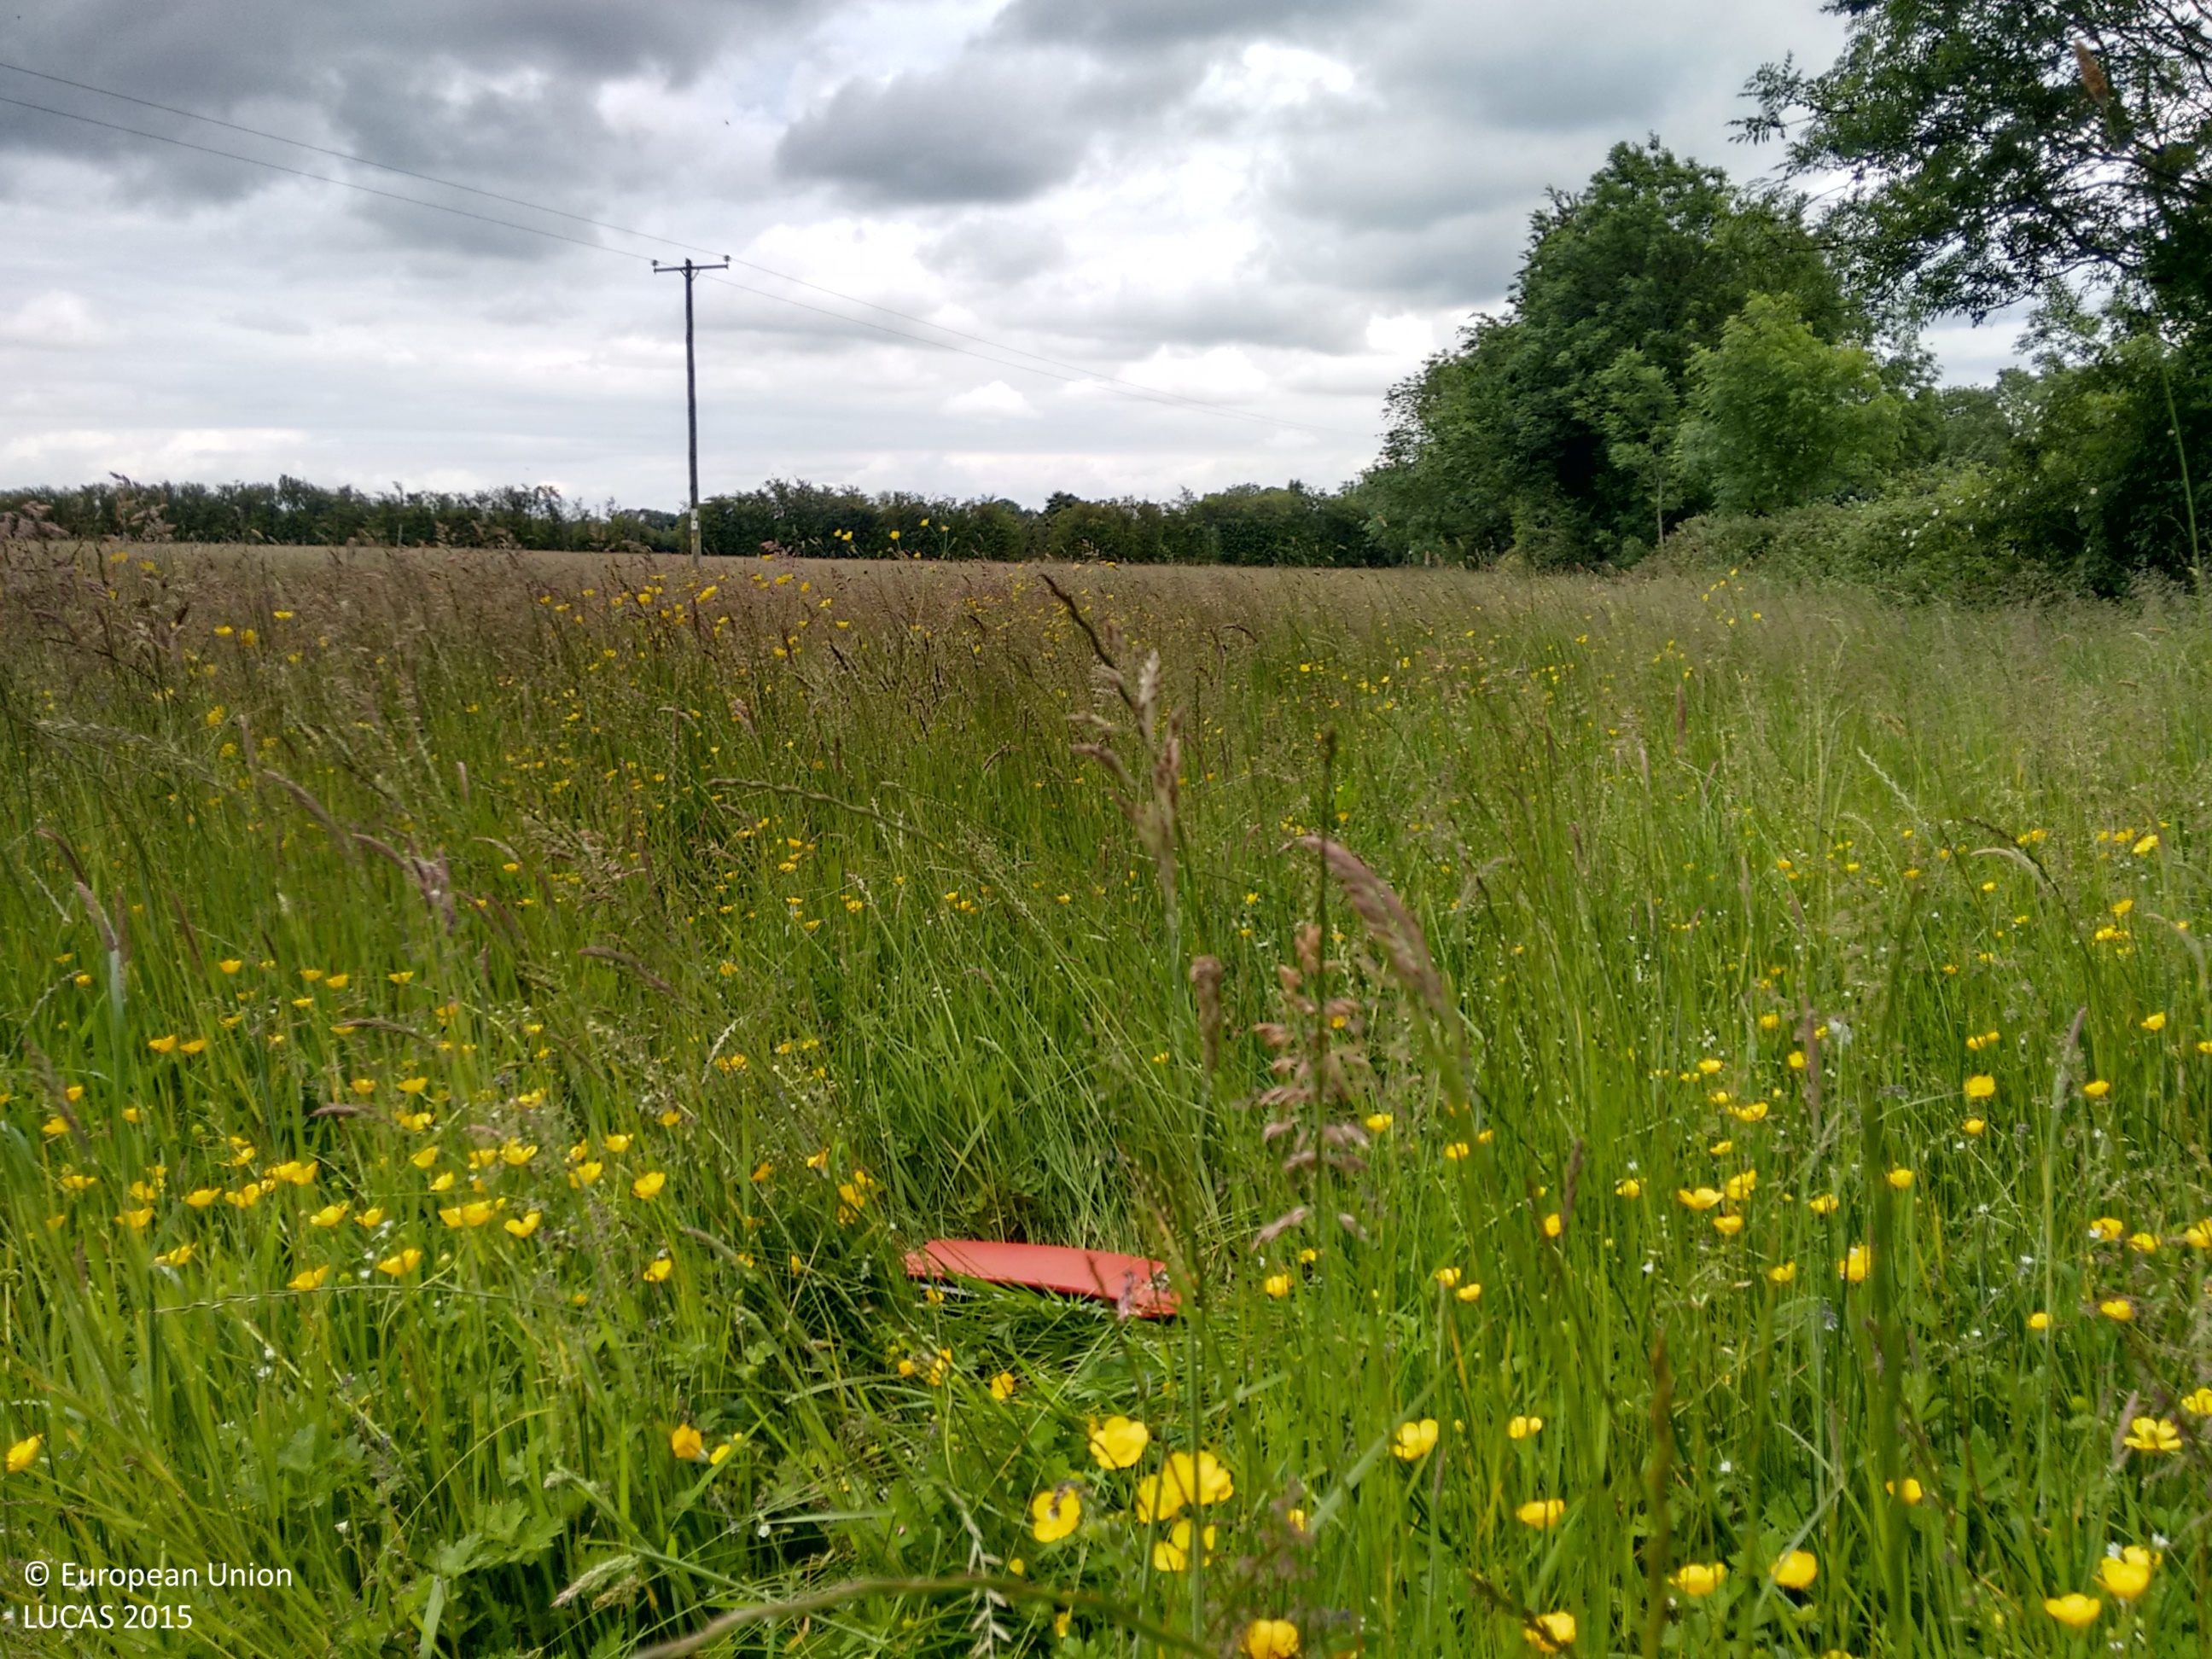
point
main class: Grassland
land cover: Grassland without tree/shrub cover
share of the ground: > 75 %
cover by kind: herbaceous plants 100 %
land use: Agriculture (excluding fallow land and kitchen gardens)
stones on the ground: < 10 %
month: June
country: IE
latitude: 53.6208
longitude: -6.7491
